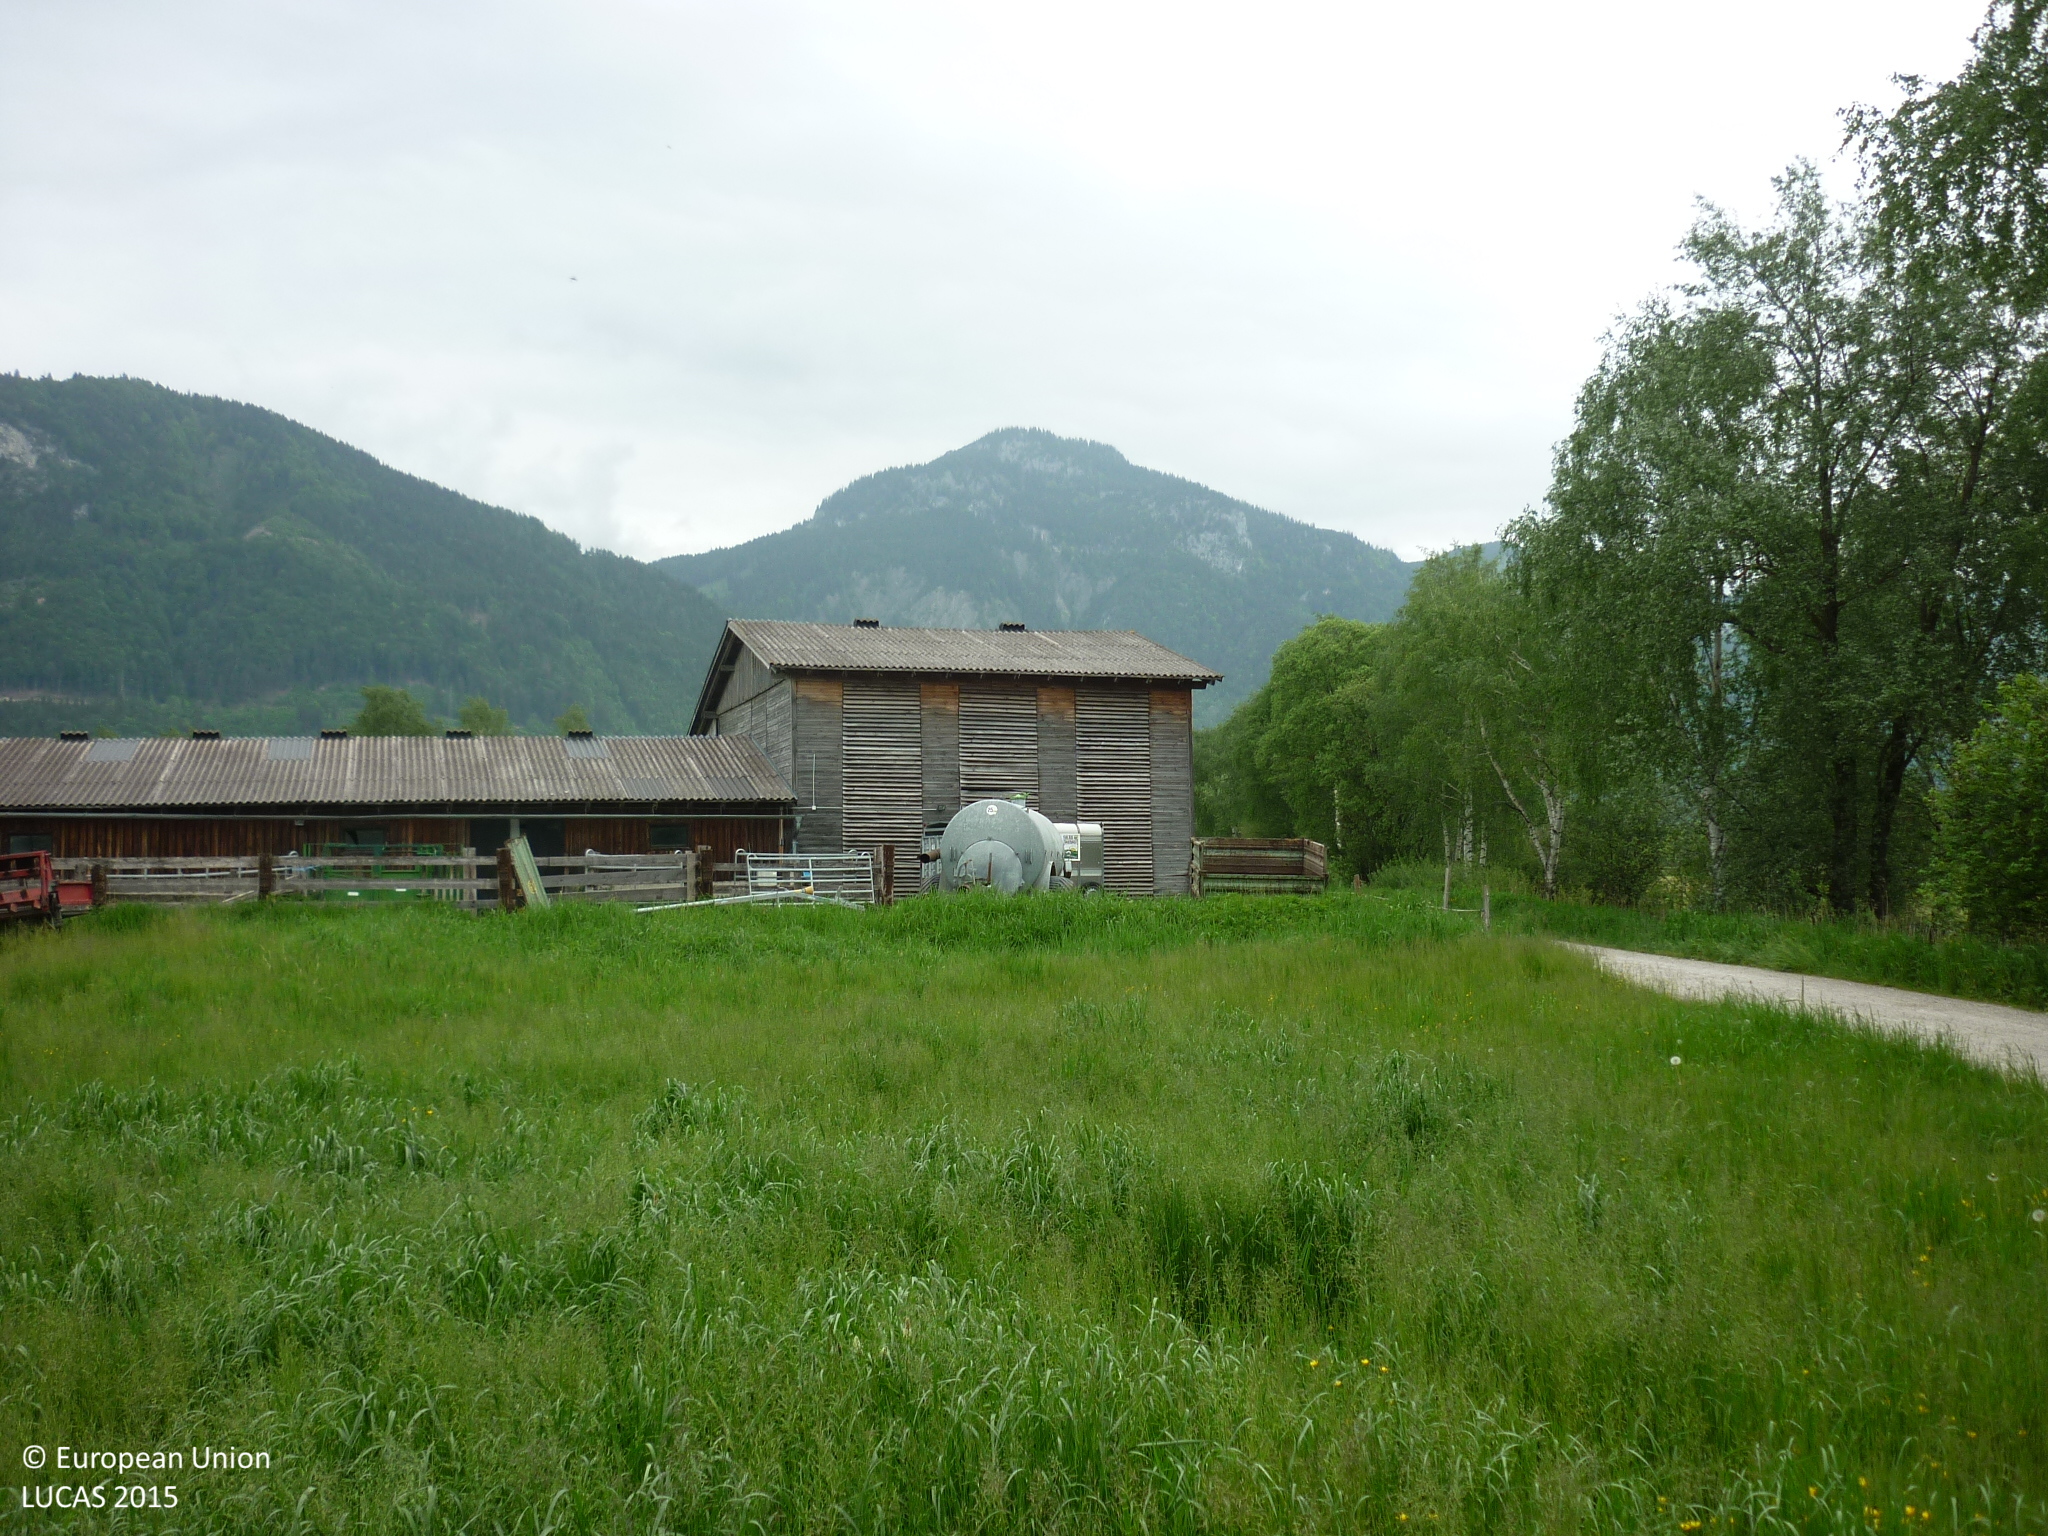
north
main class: Grassland
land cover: Grassland without tree/shrub cover
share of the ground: > 75 %
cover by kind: herbaceous plants 100 %
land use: Agriculture (excluding fallow land and kitchen gardens)
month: May
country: AT
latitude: 47.5165
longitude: 14.1021
